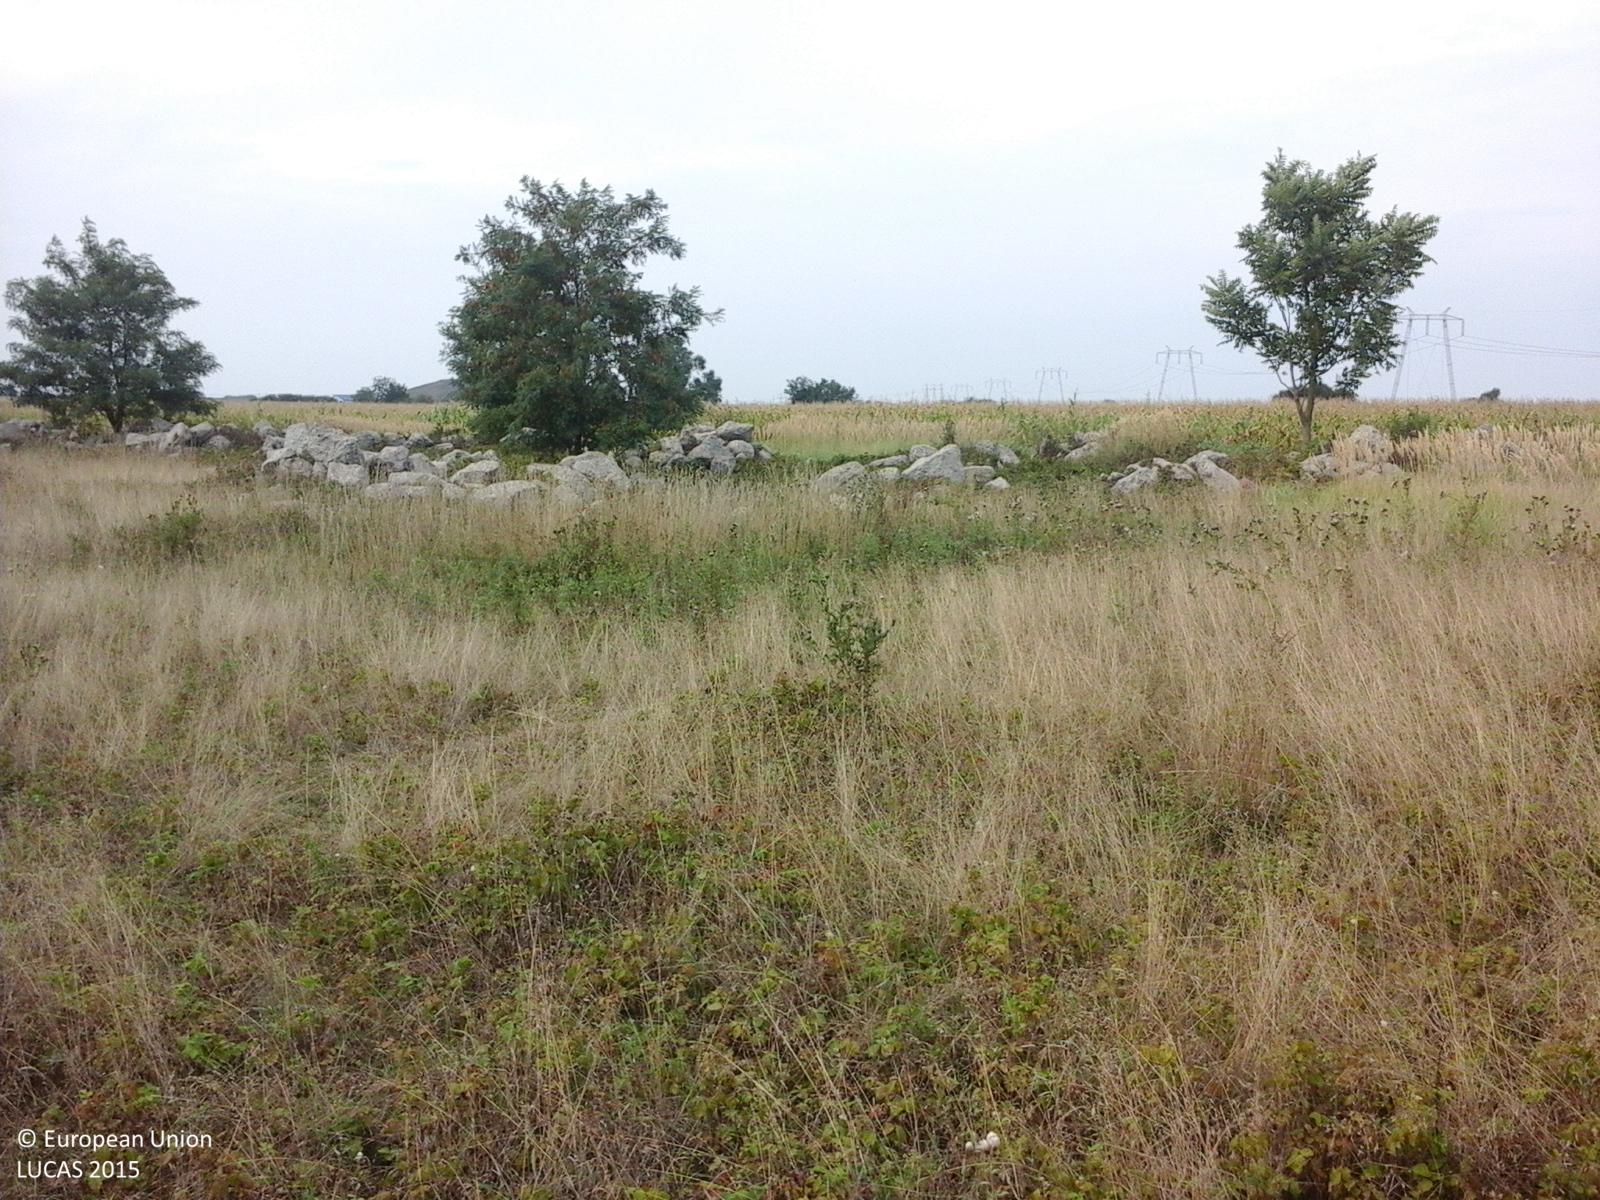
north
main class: Cropland
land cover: Maize
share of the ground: > 75 %
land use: Agriculture (excluding fallow land and kitchen gardens)
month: August
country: RO
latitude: 46.2175
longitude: 21.3515
